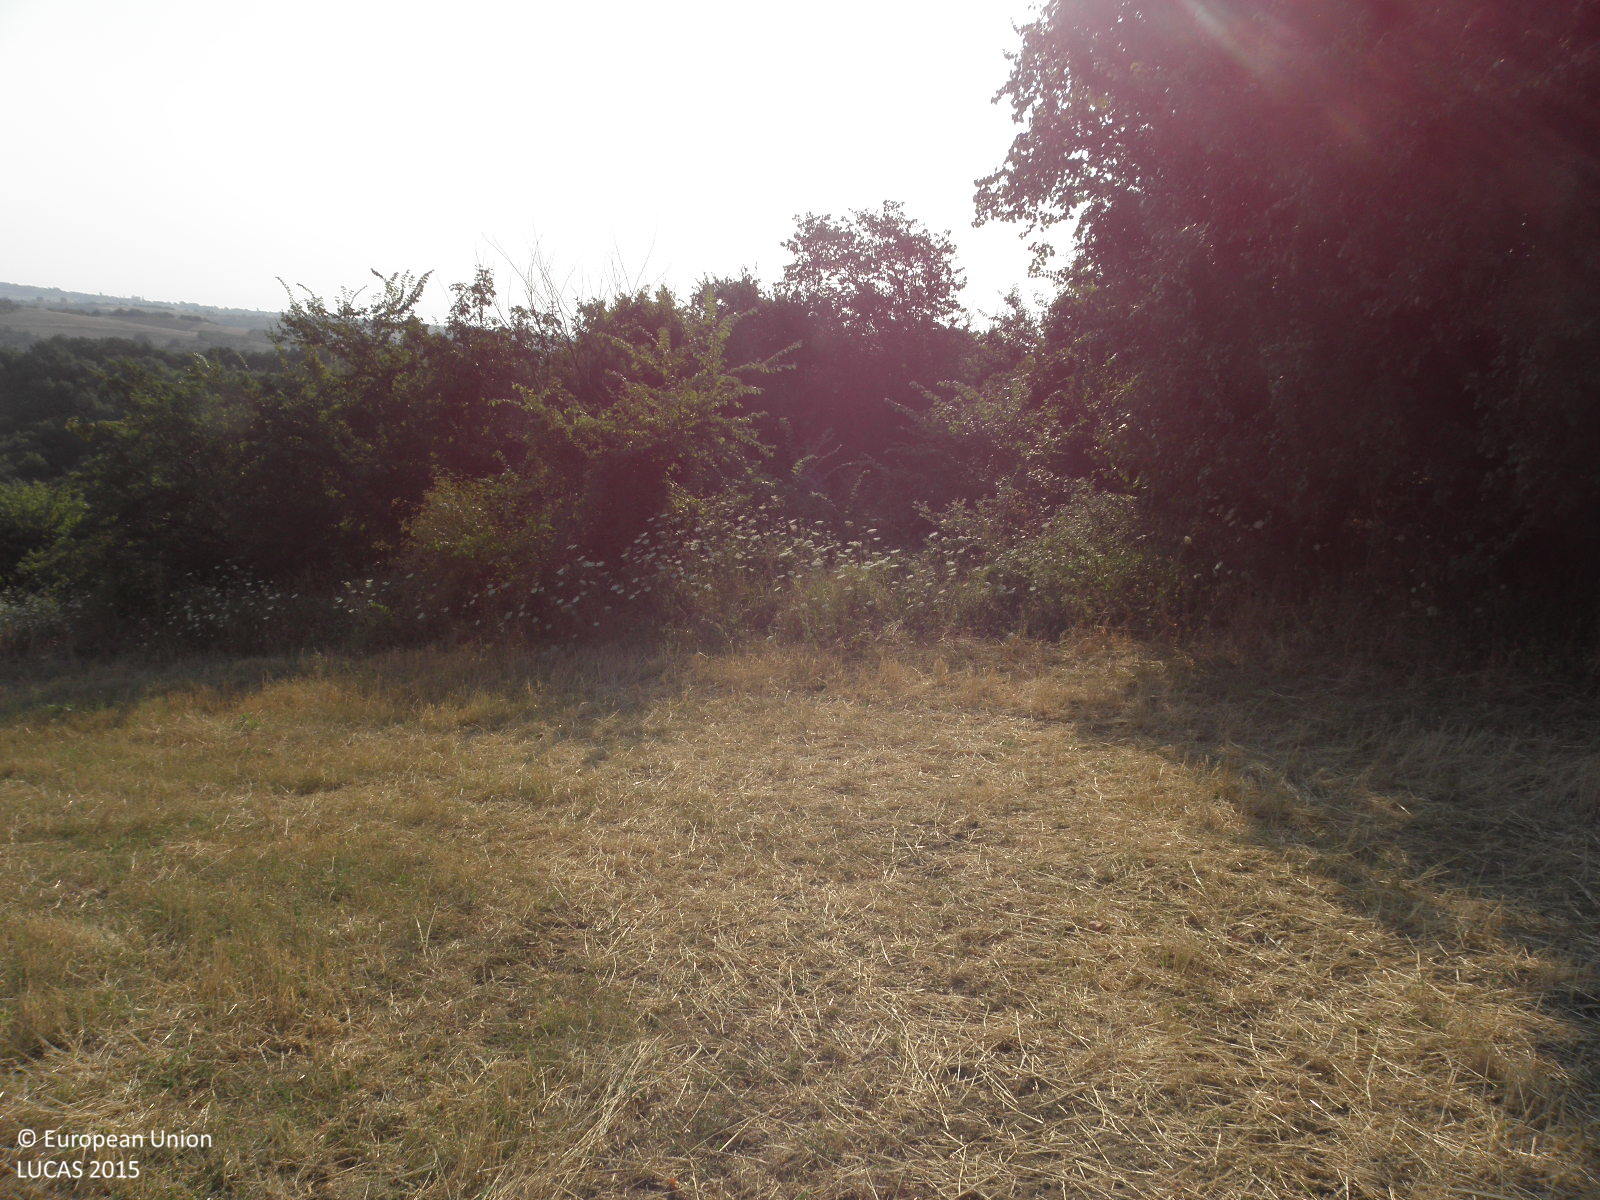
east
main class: Cropland
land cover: Common wheat
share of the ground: > 75 %
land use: Agriculture (excluding fallow land and kitchen gardens)
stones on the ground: 10 - 25 %
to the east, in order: Common wheat; Shrubland without tree cover; Ditches and canals; Broadleaved woodland; Shrubland without tree cover; Tracks; Tobacco
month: July
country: GR
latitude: 40.3642
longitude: 22.4697
